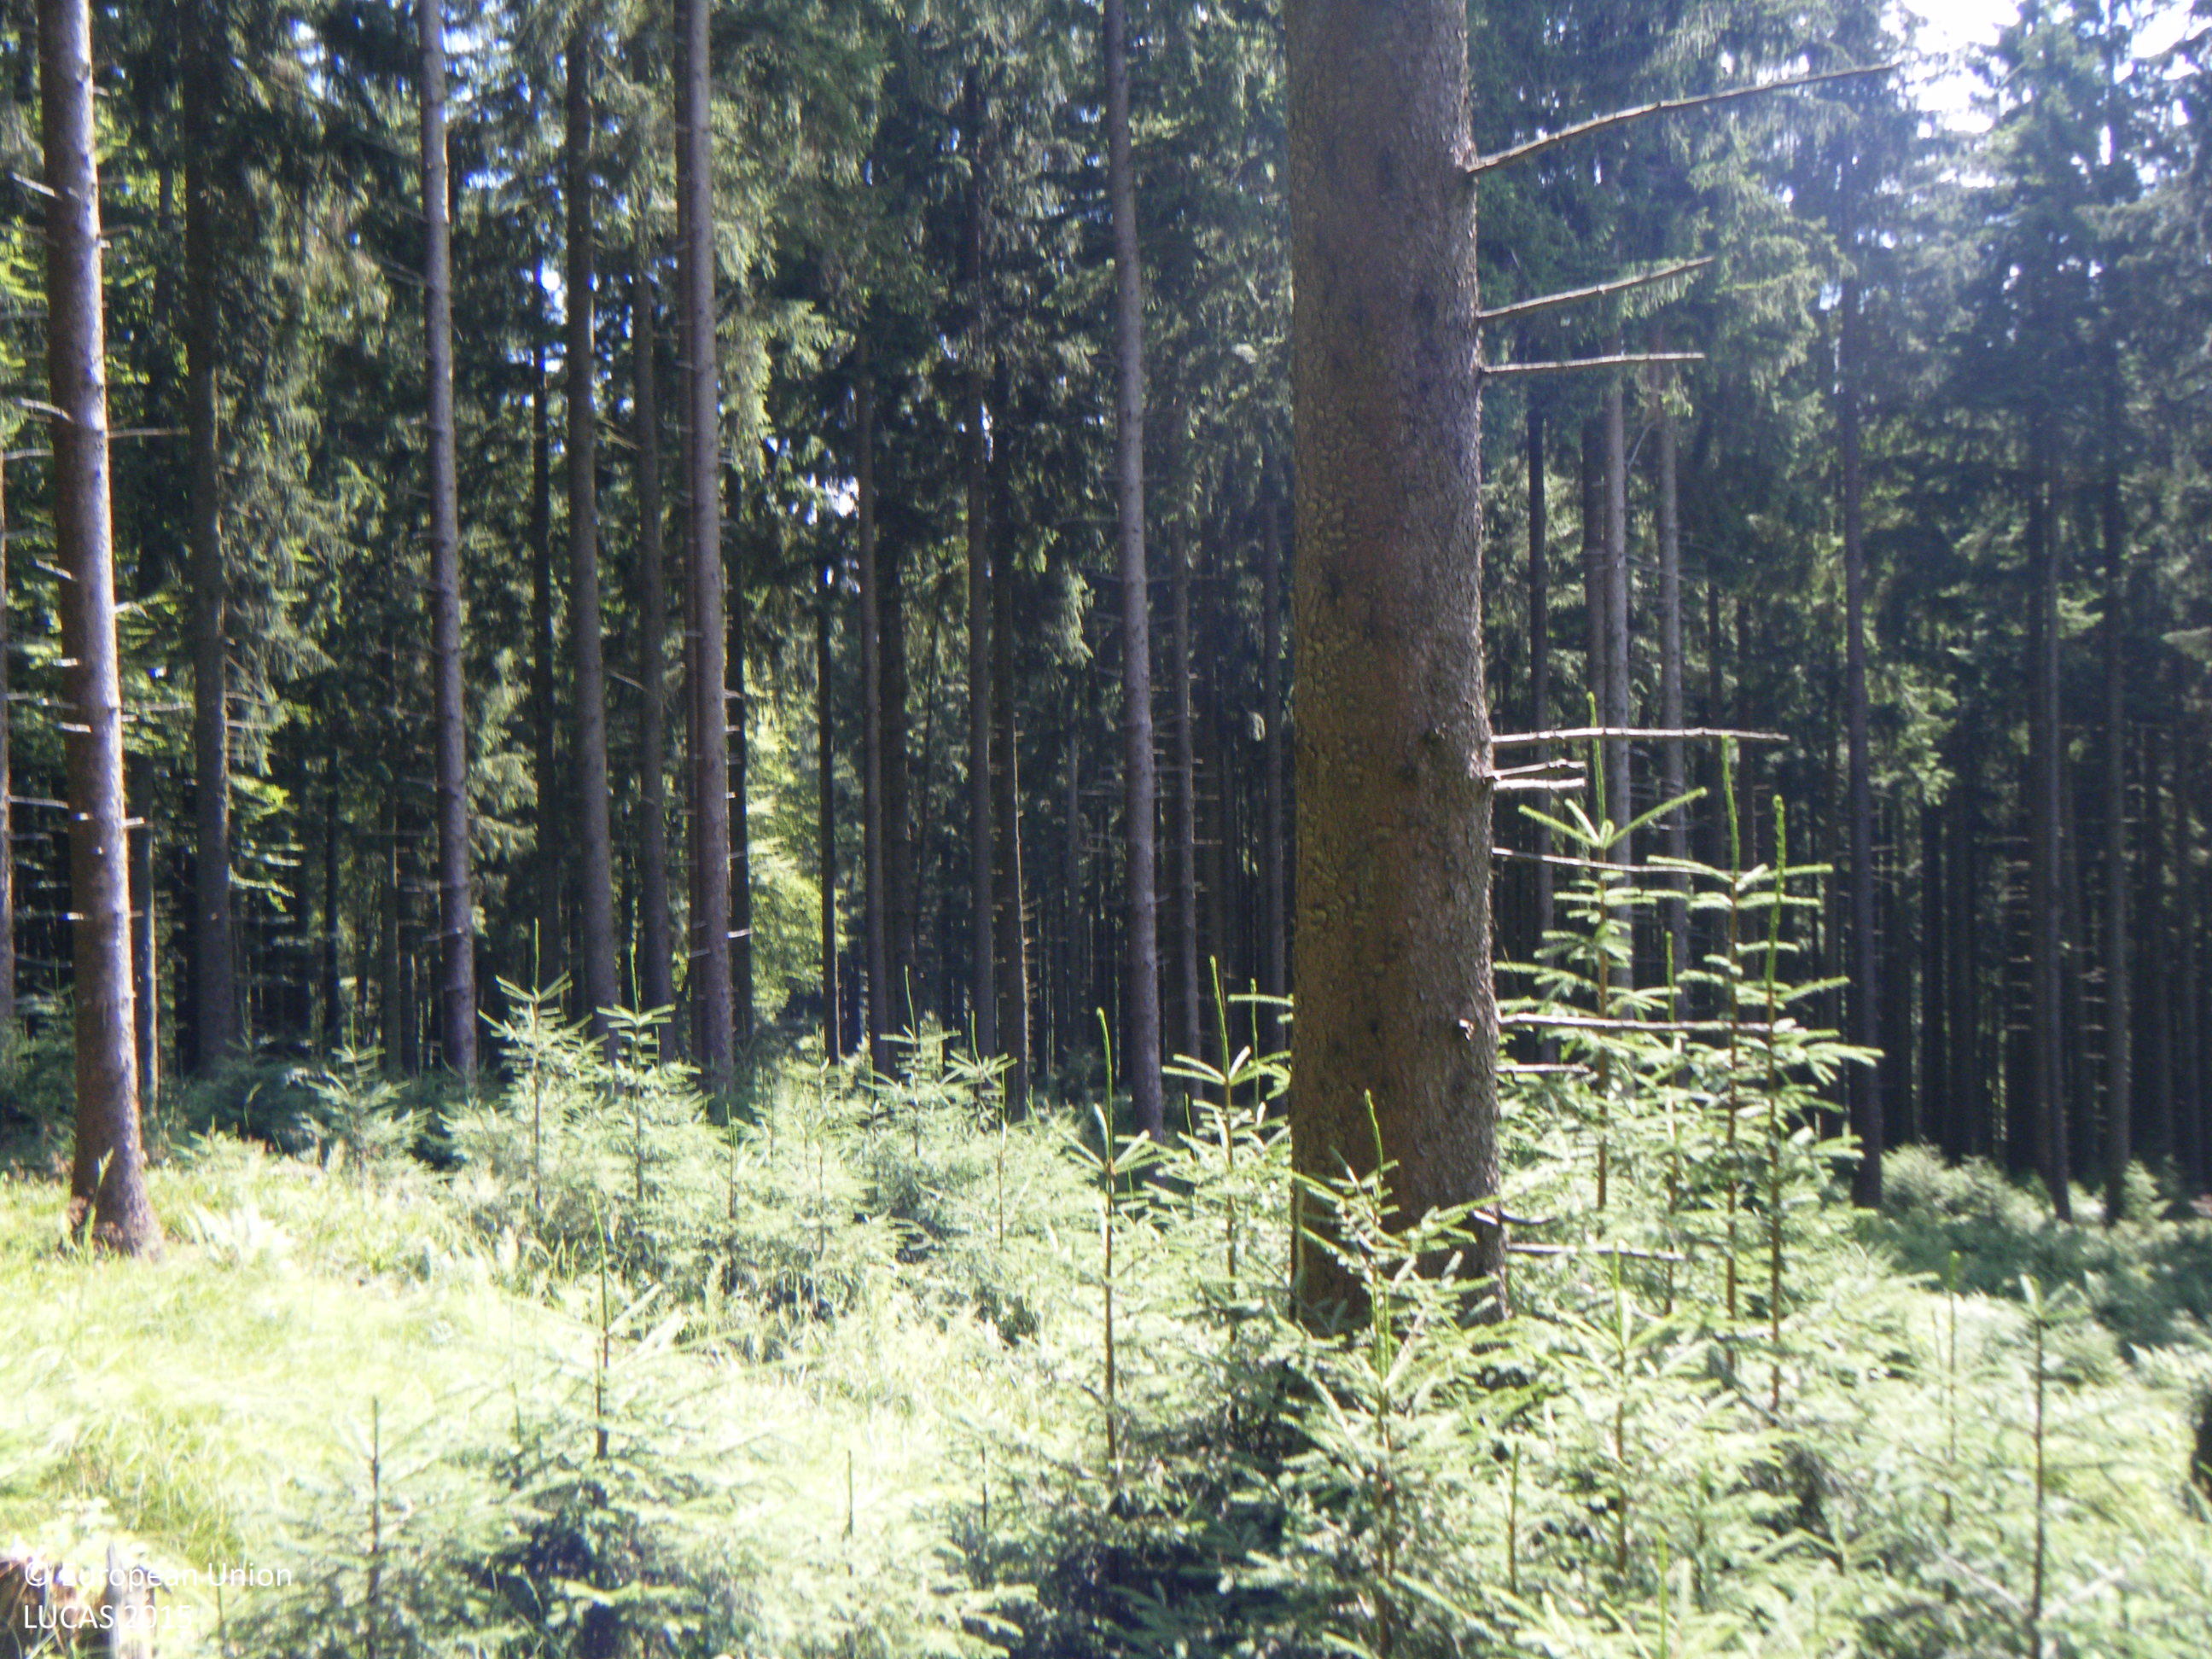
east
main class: Woodland
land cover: Spruce dominated coniferous woodland
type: alpine coniferous forest
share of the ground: > 75 %
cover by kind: coniferous forest trees 80 %, shrubs 10 %, herbaceous plants 10 %
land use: Forestry
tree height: > 5 m
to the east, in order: Spruce dominated coniferous woodland; Shrubland with sparse tree cover; Spruce dominated coniferous woodland; Broadleaved woodland; Spruce dominated coniferous woodland; Tracks; Other mixed woodland
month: July
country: AT
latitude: 47.8810
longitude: 13.4622
